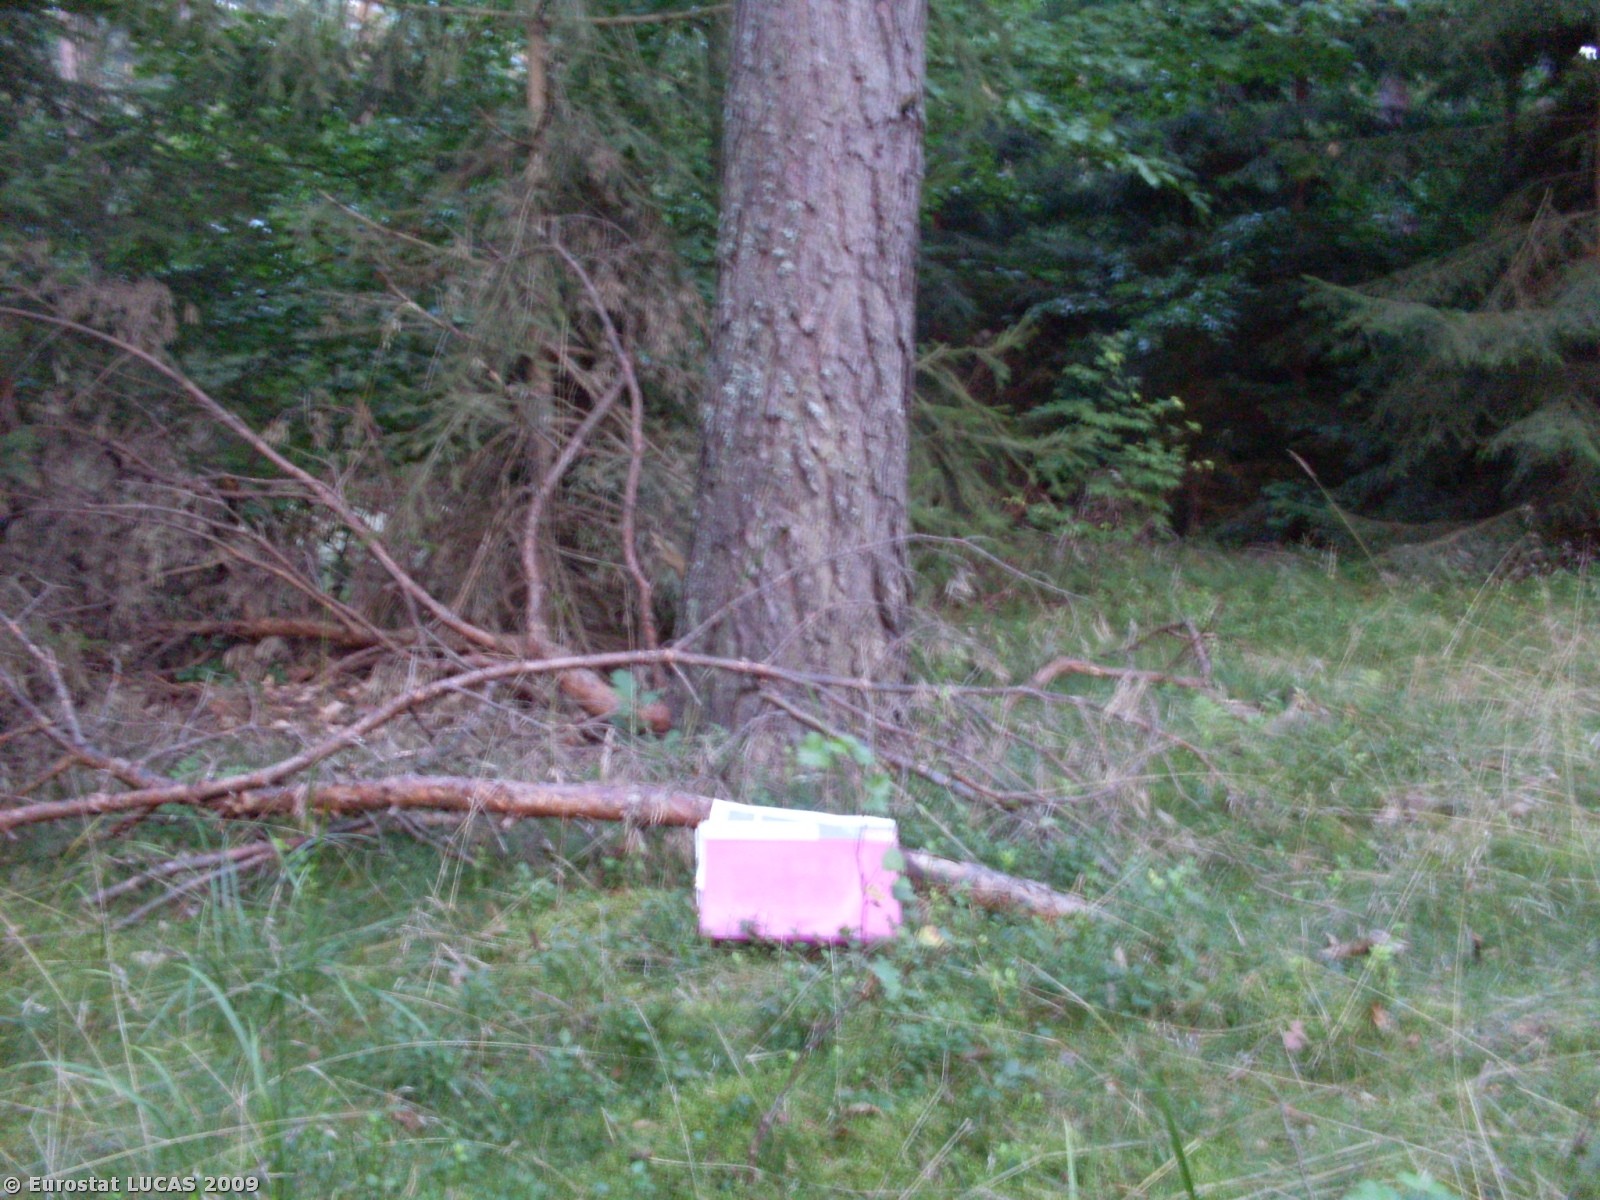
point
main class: Woodland
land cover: Mixed woodland
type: hemiboreal forest and nemoral coniferous forest and mixed broadleaved-coniferous forest
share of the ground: > 75 %
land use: Forestry
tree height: > 5 m
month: July
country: PL
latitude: 53.0048
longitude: 15.9212
